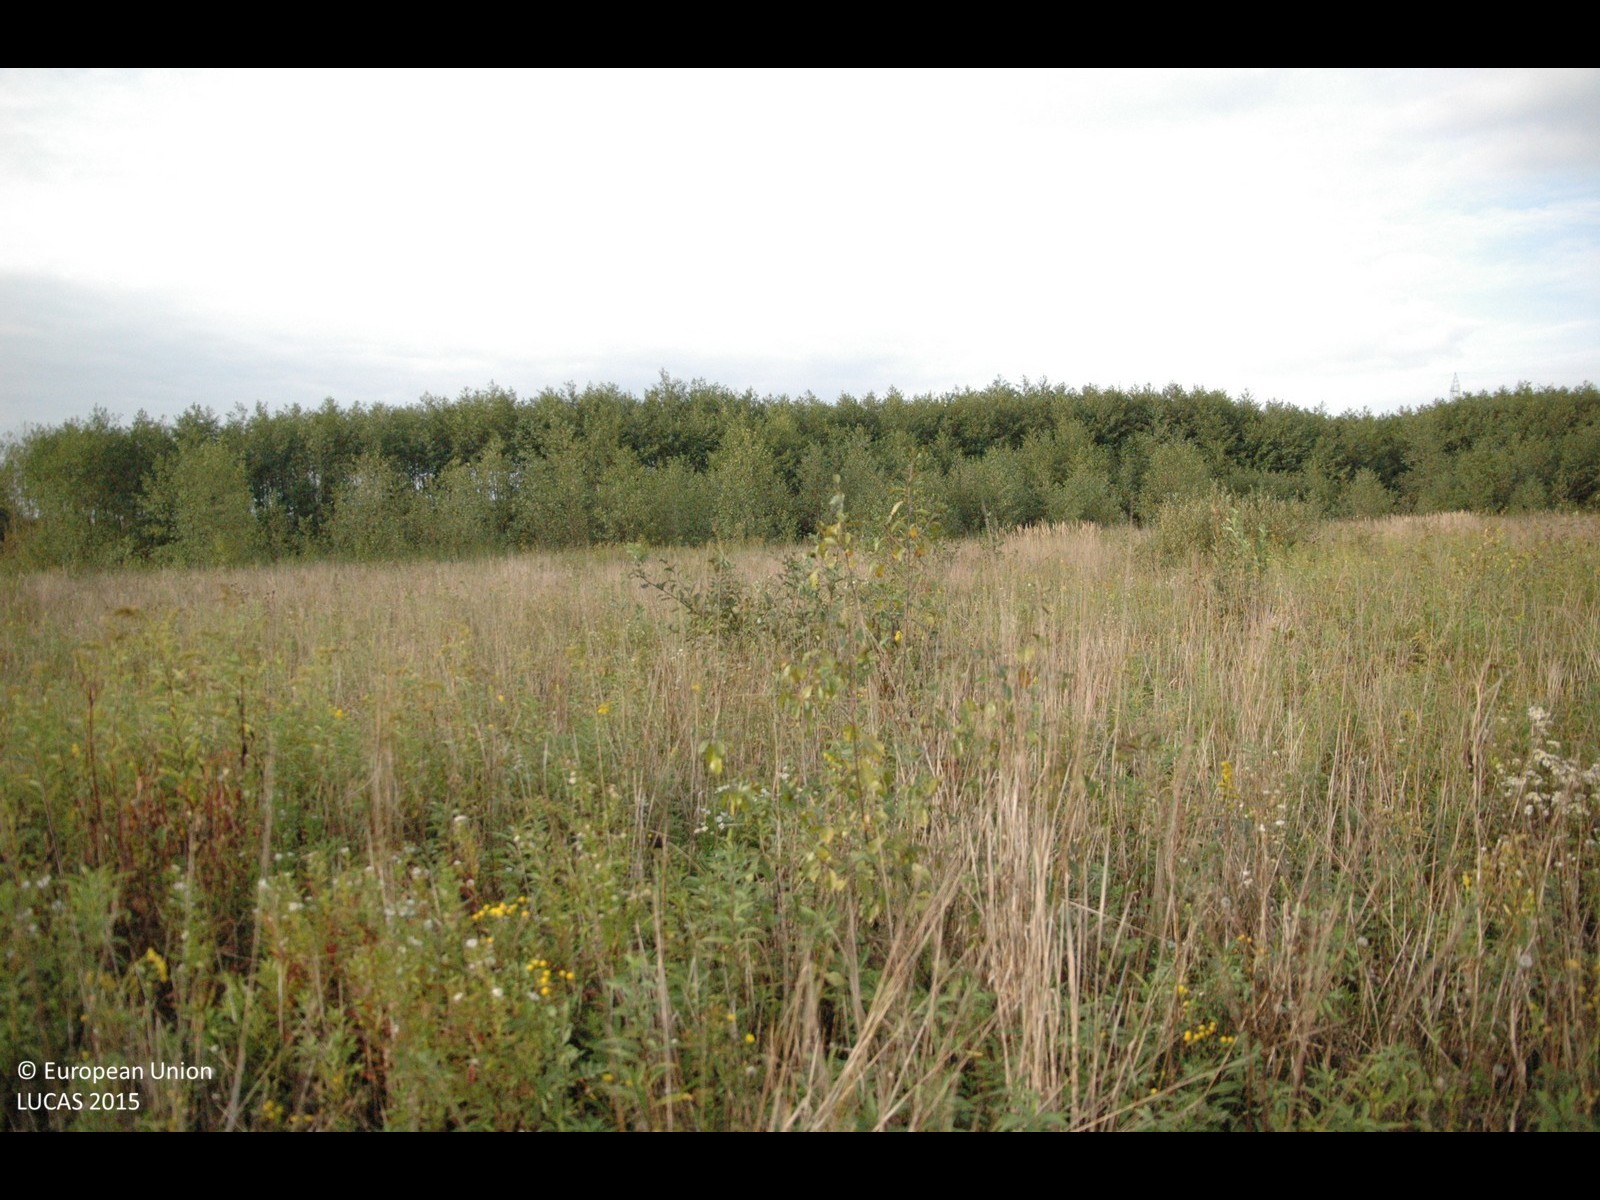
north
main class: Grassland
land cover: Grassland without tree/shrub cover
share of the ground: > 75 %
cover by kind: herbaceous plants 100 %
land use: Agriculture (excluding fallow land and kitchen gardens)
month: October
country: HR
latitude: 45.5549
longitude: 16.2362
